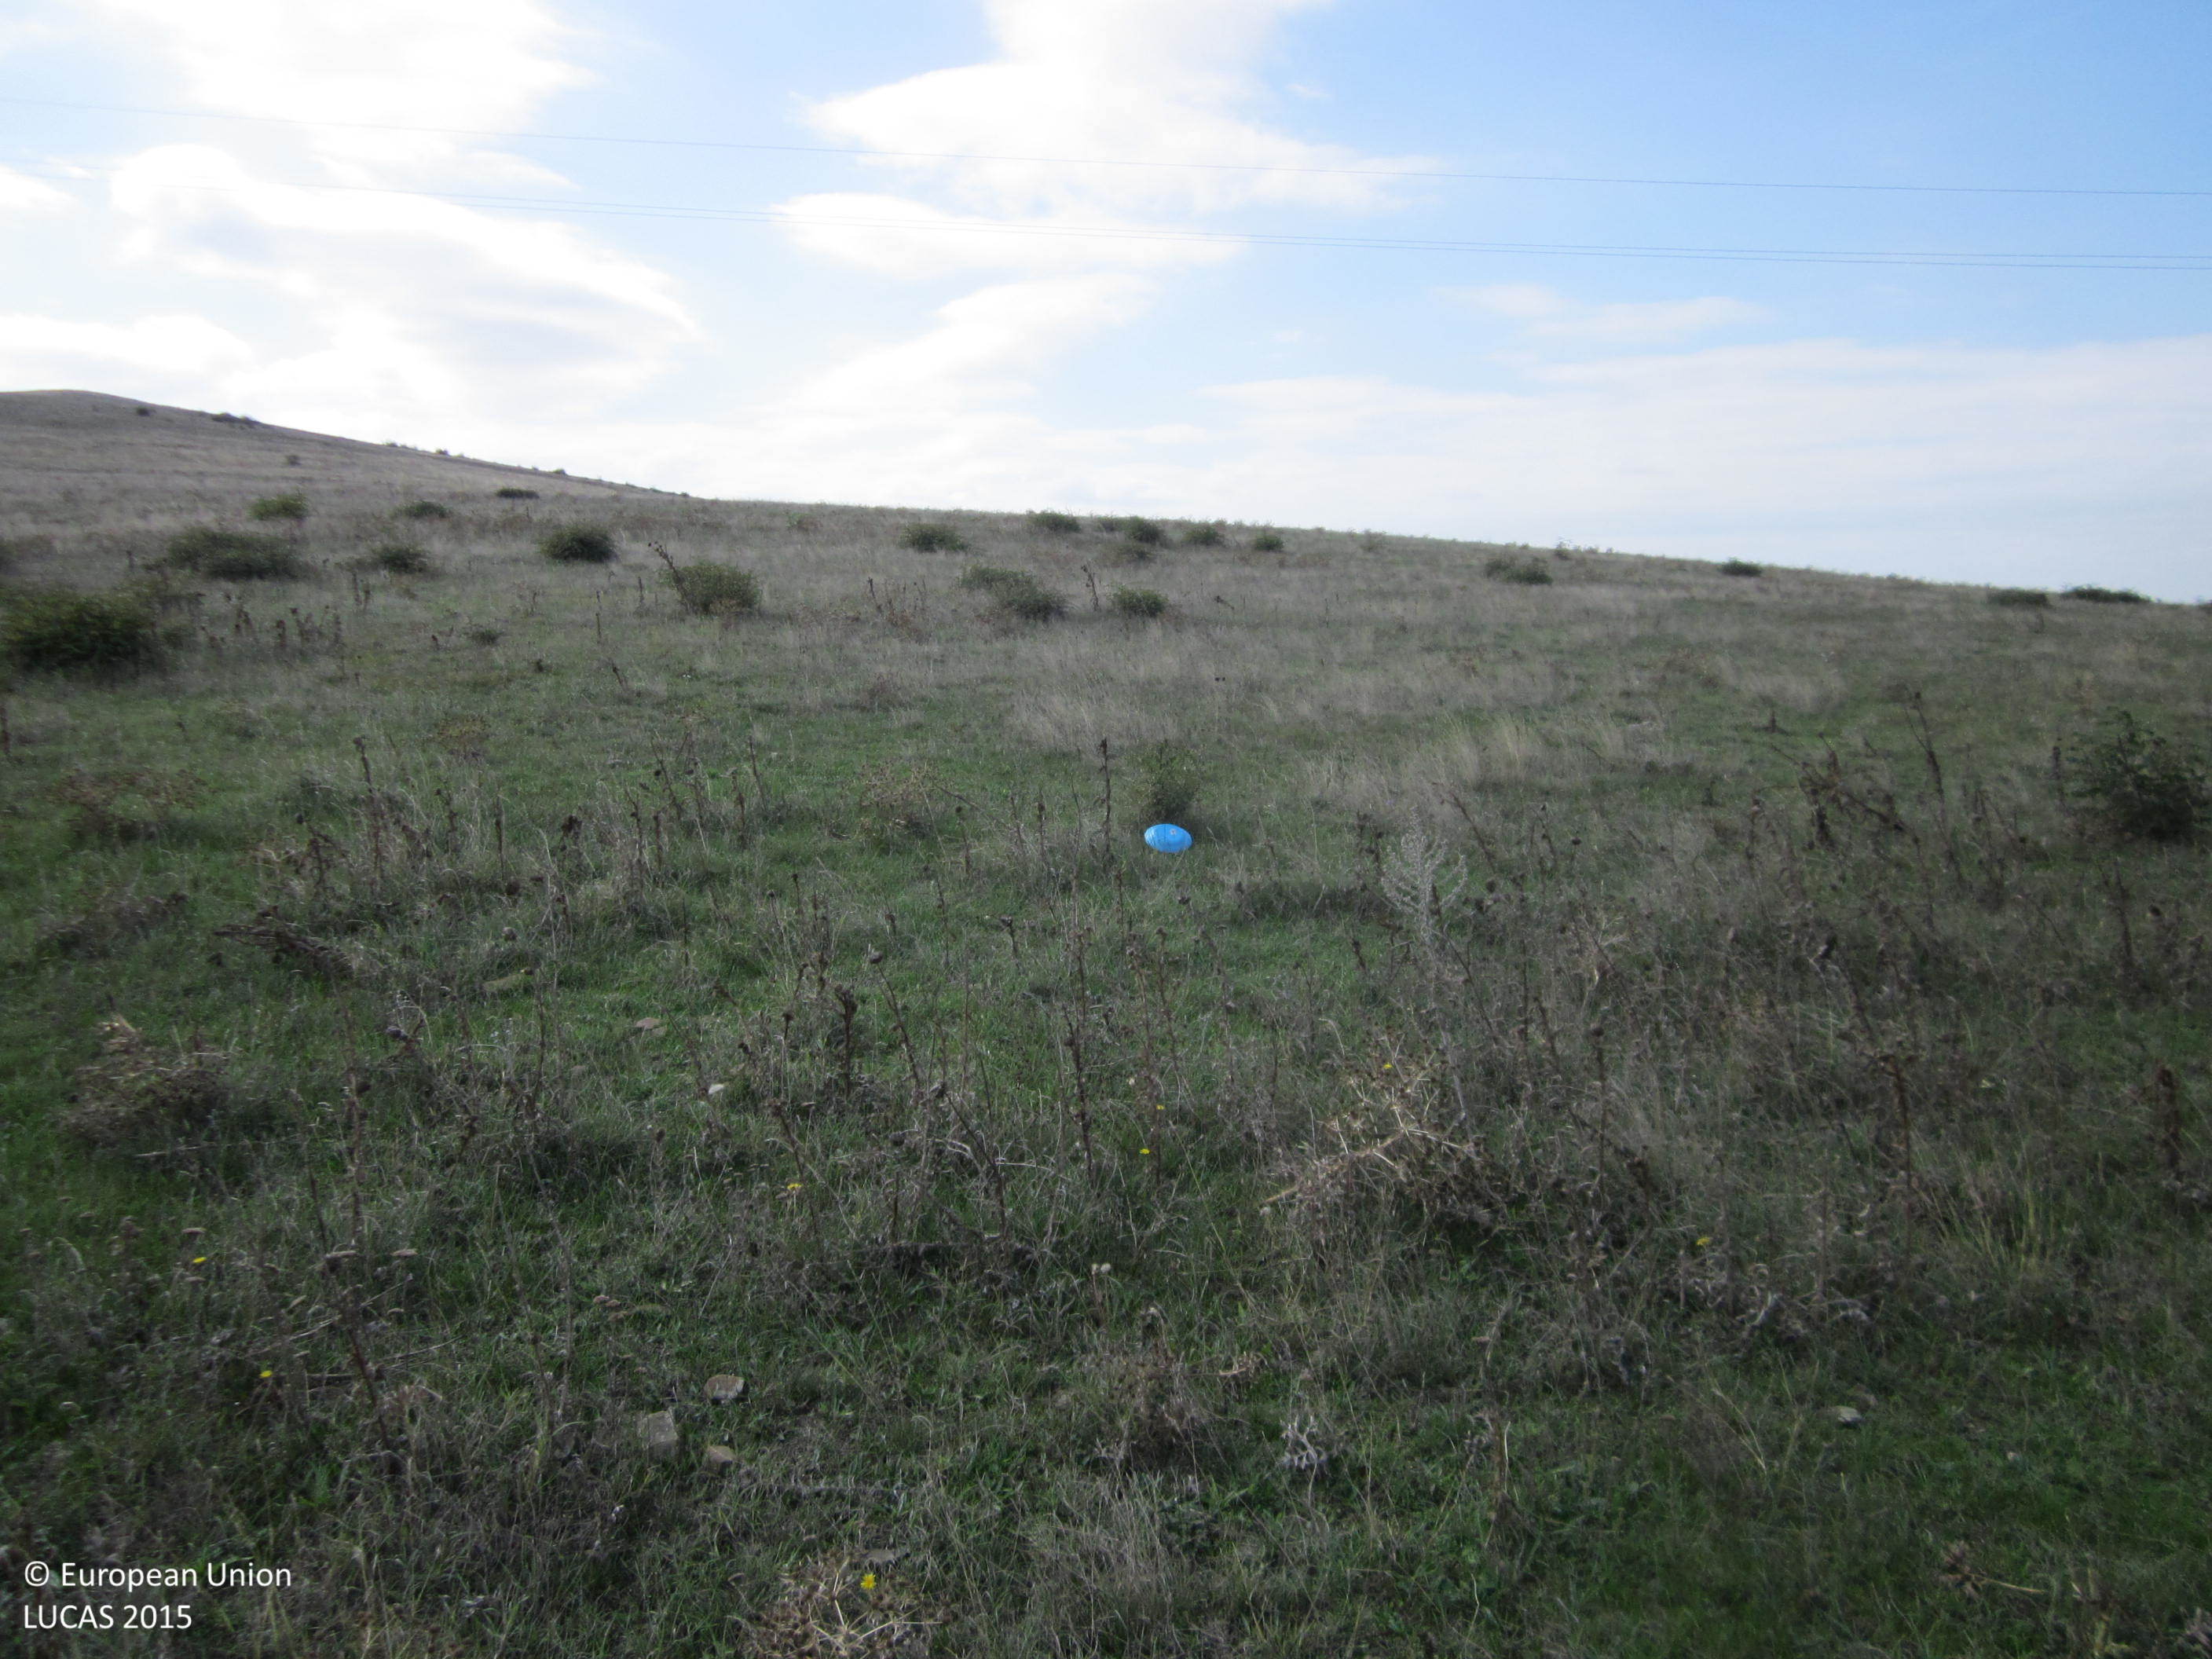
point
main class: Grassland
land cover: Grassland without tree/shrub cover
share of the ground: > 75 %
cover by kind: herbaceous plants 100 %
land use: Agriculture (excluding fallow land and kitchen gardens)
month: October
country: BG
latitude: 42.5951
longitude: 26.8345
